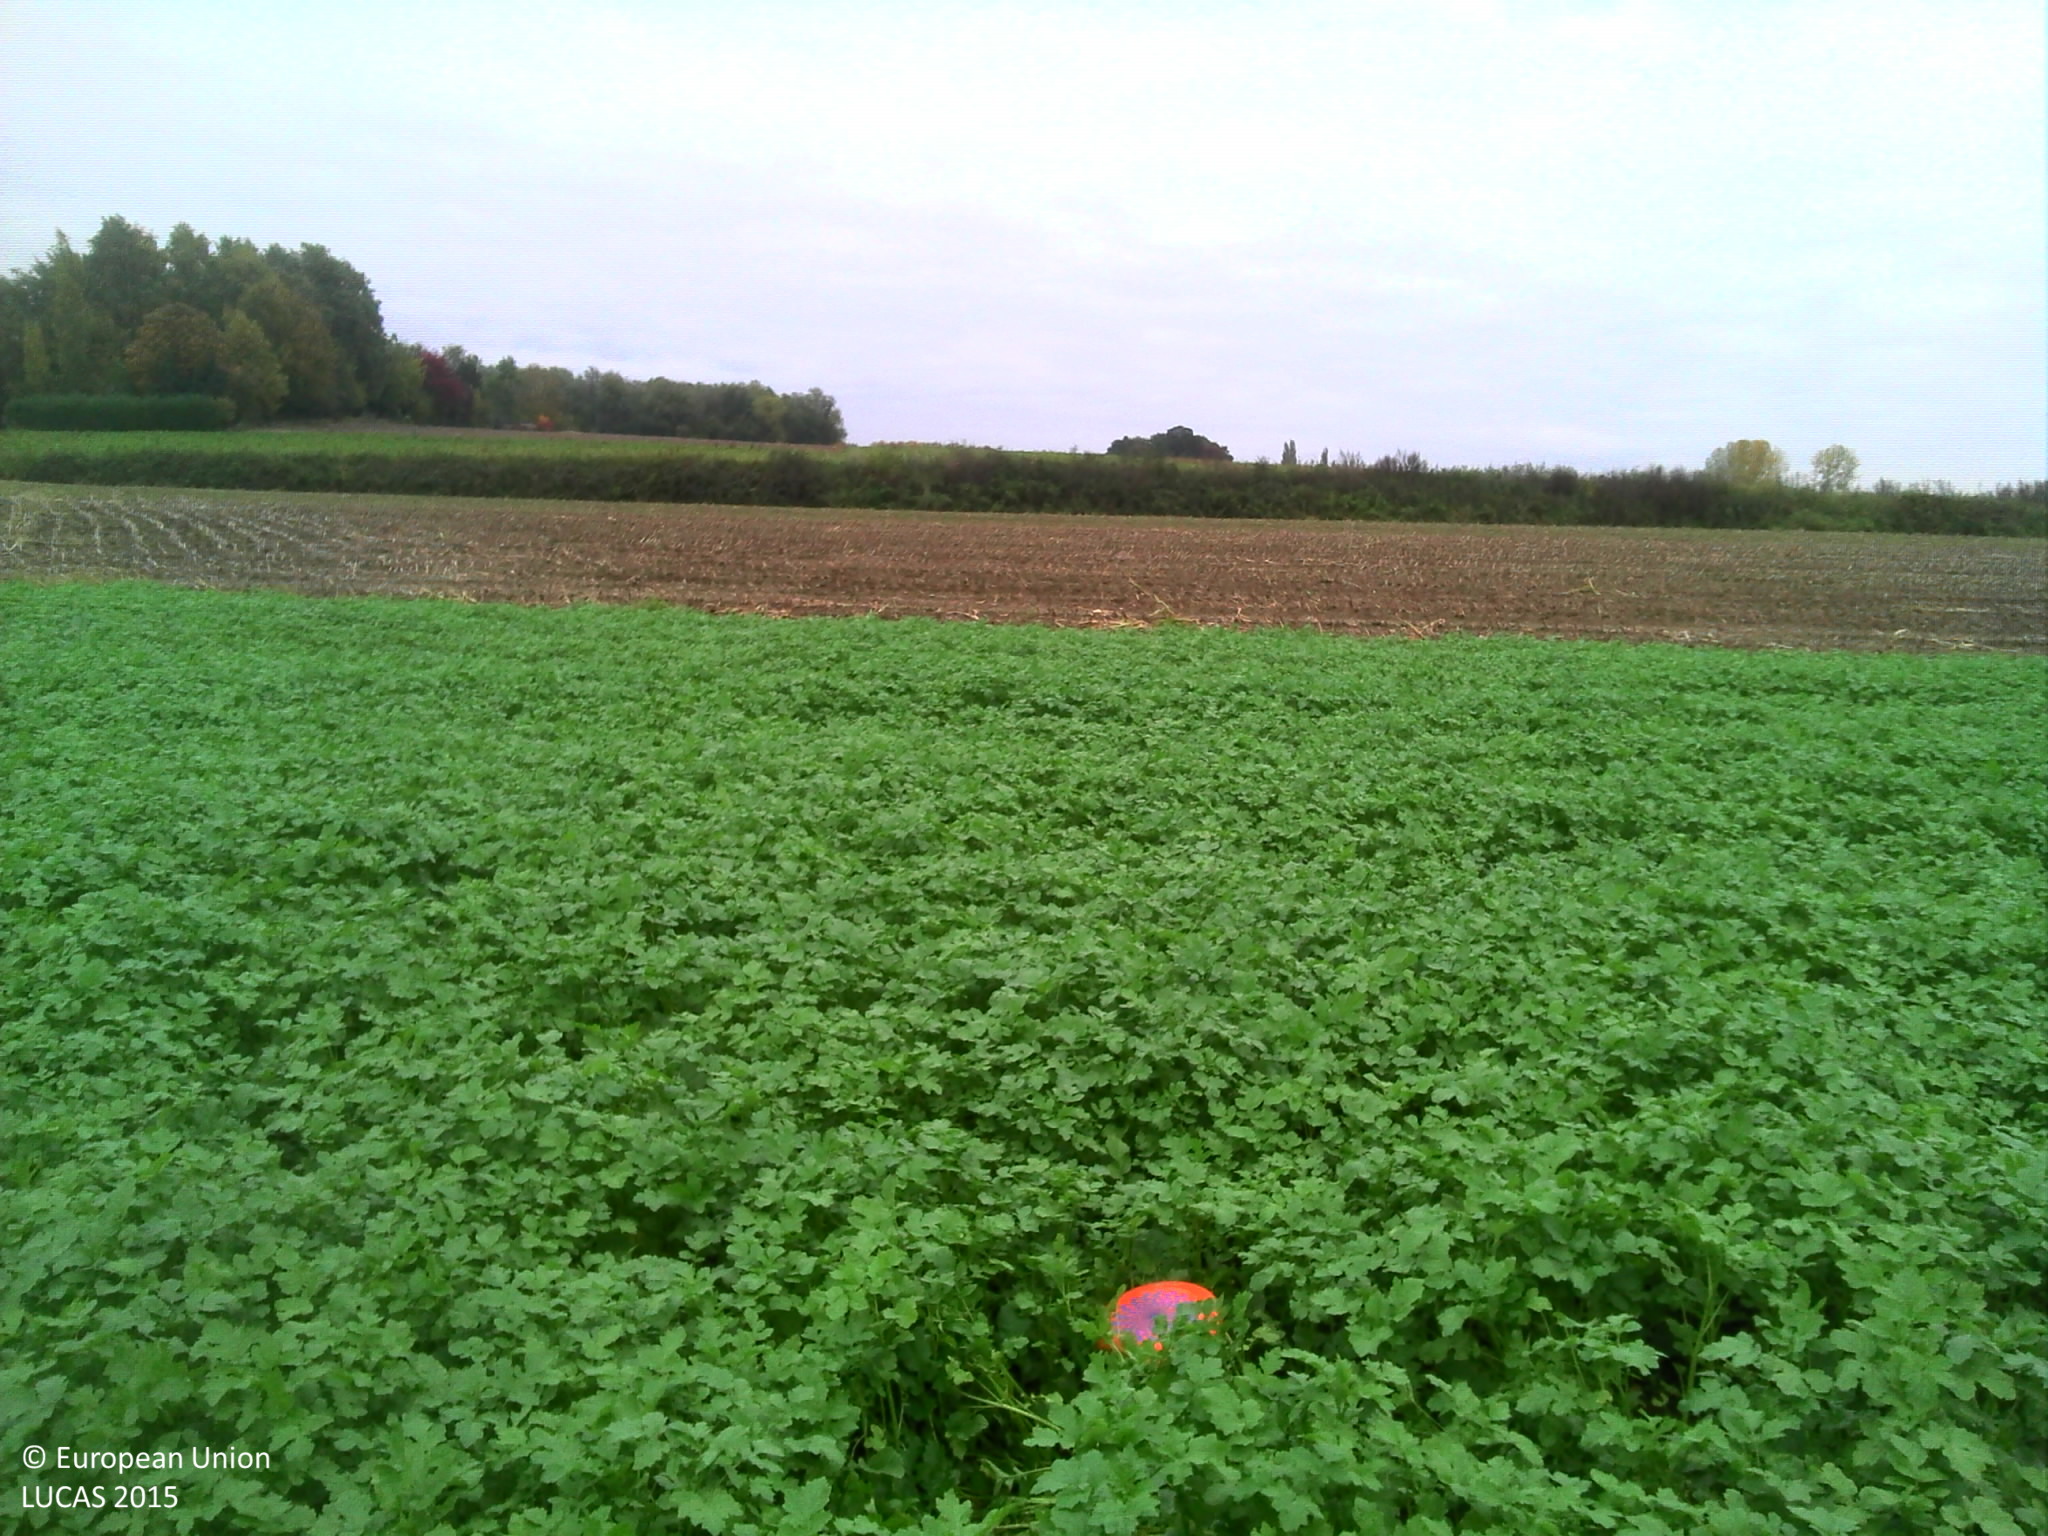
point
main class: Cropland
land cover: Other fibre and oleaginous crops
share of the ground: > 75 %
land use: Agriculture (excluding fallow land and kitchen gardens)
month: October
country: BE
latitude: 50.8980
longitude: 4.1223
